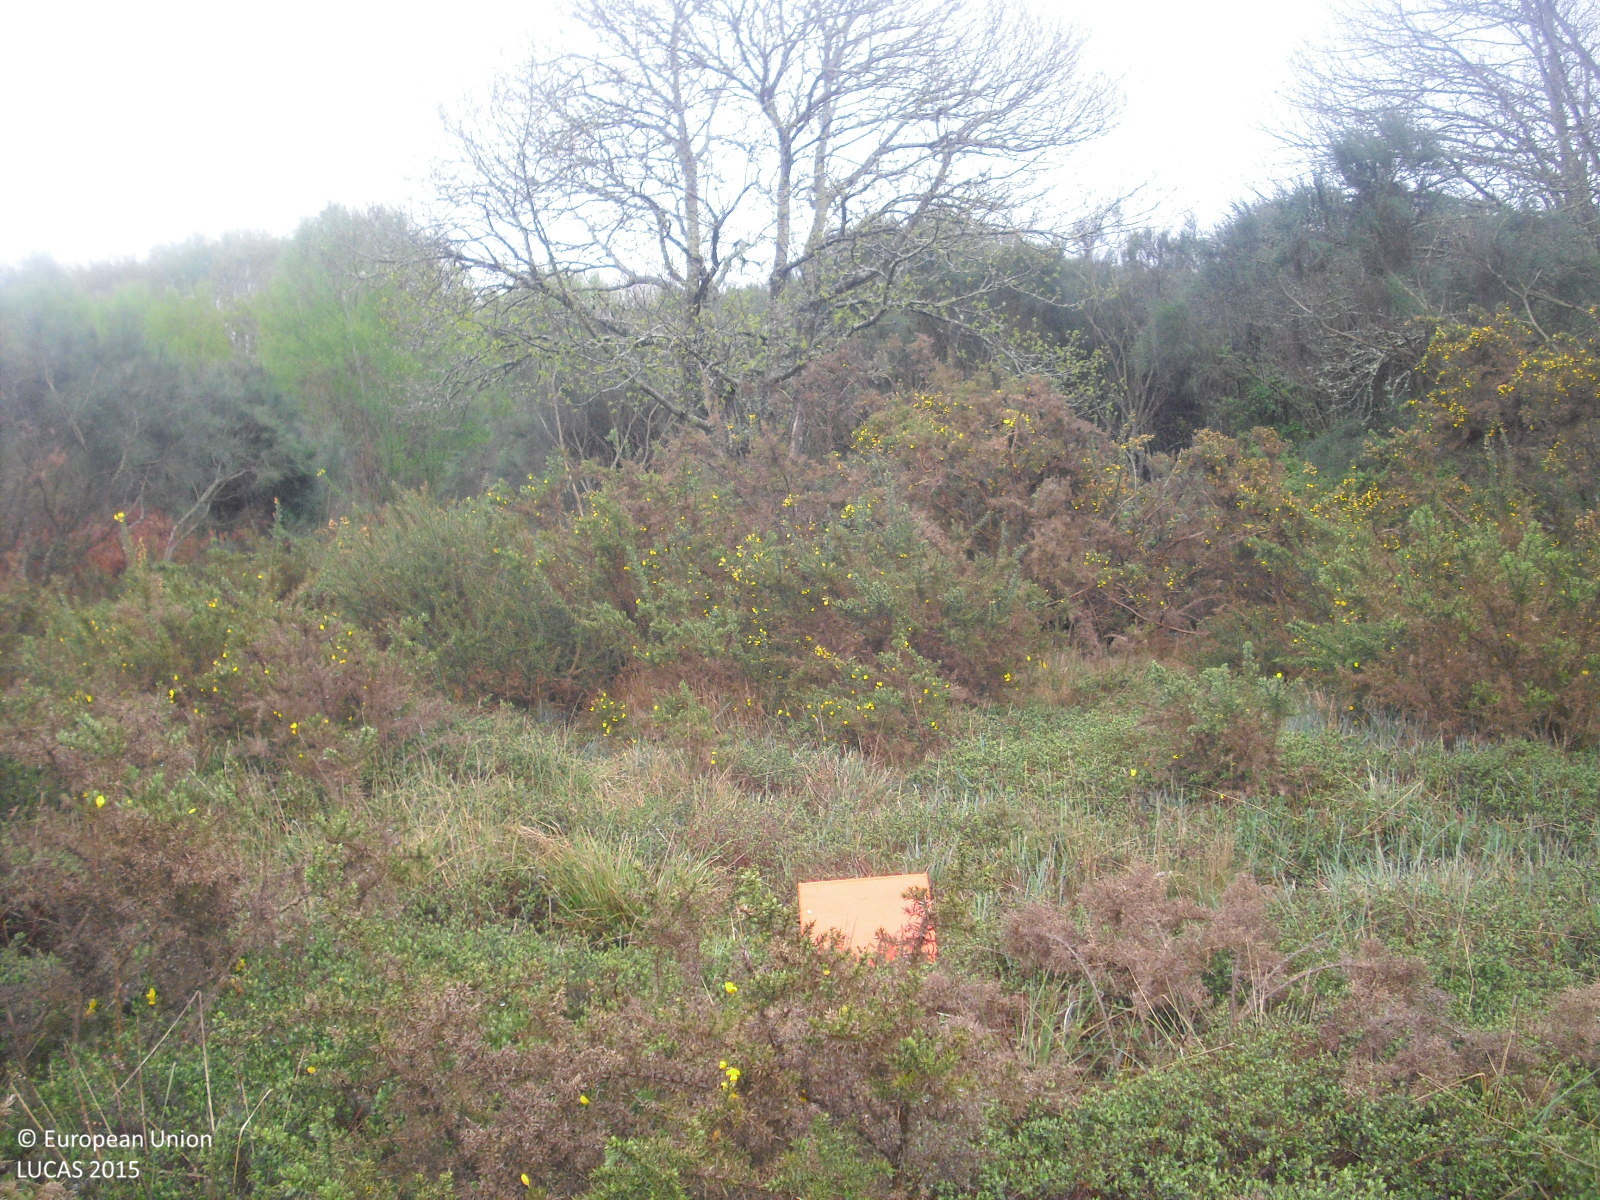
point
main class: Shrubland
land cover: Shrubland with sparse tree cover
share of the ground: 50 - 75 %
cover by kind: shrubs 85 %, herbaceous plants 10 %, broadleaved forest trees 5 %
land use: Abandoned areas
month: April
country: ES
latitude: 42.1203
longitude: -7.8668
